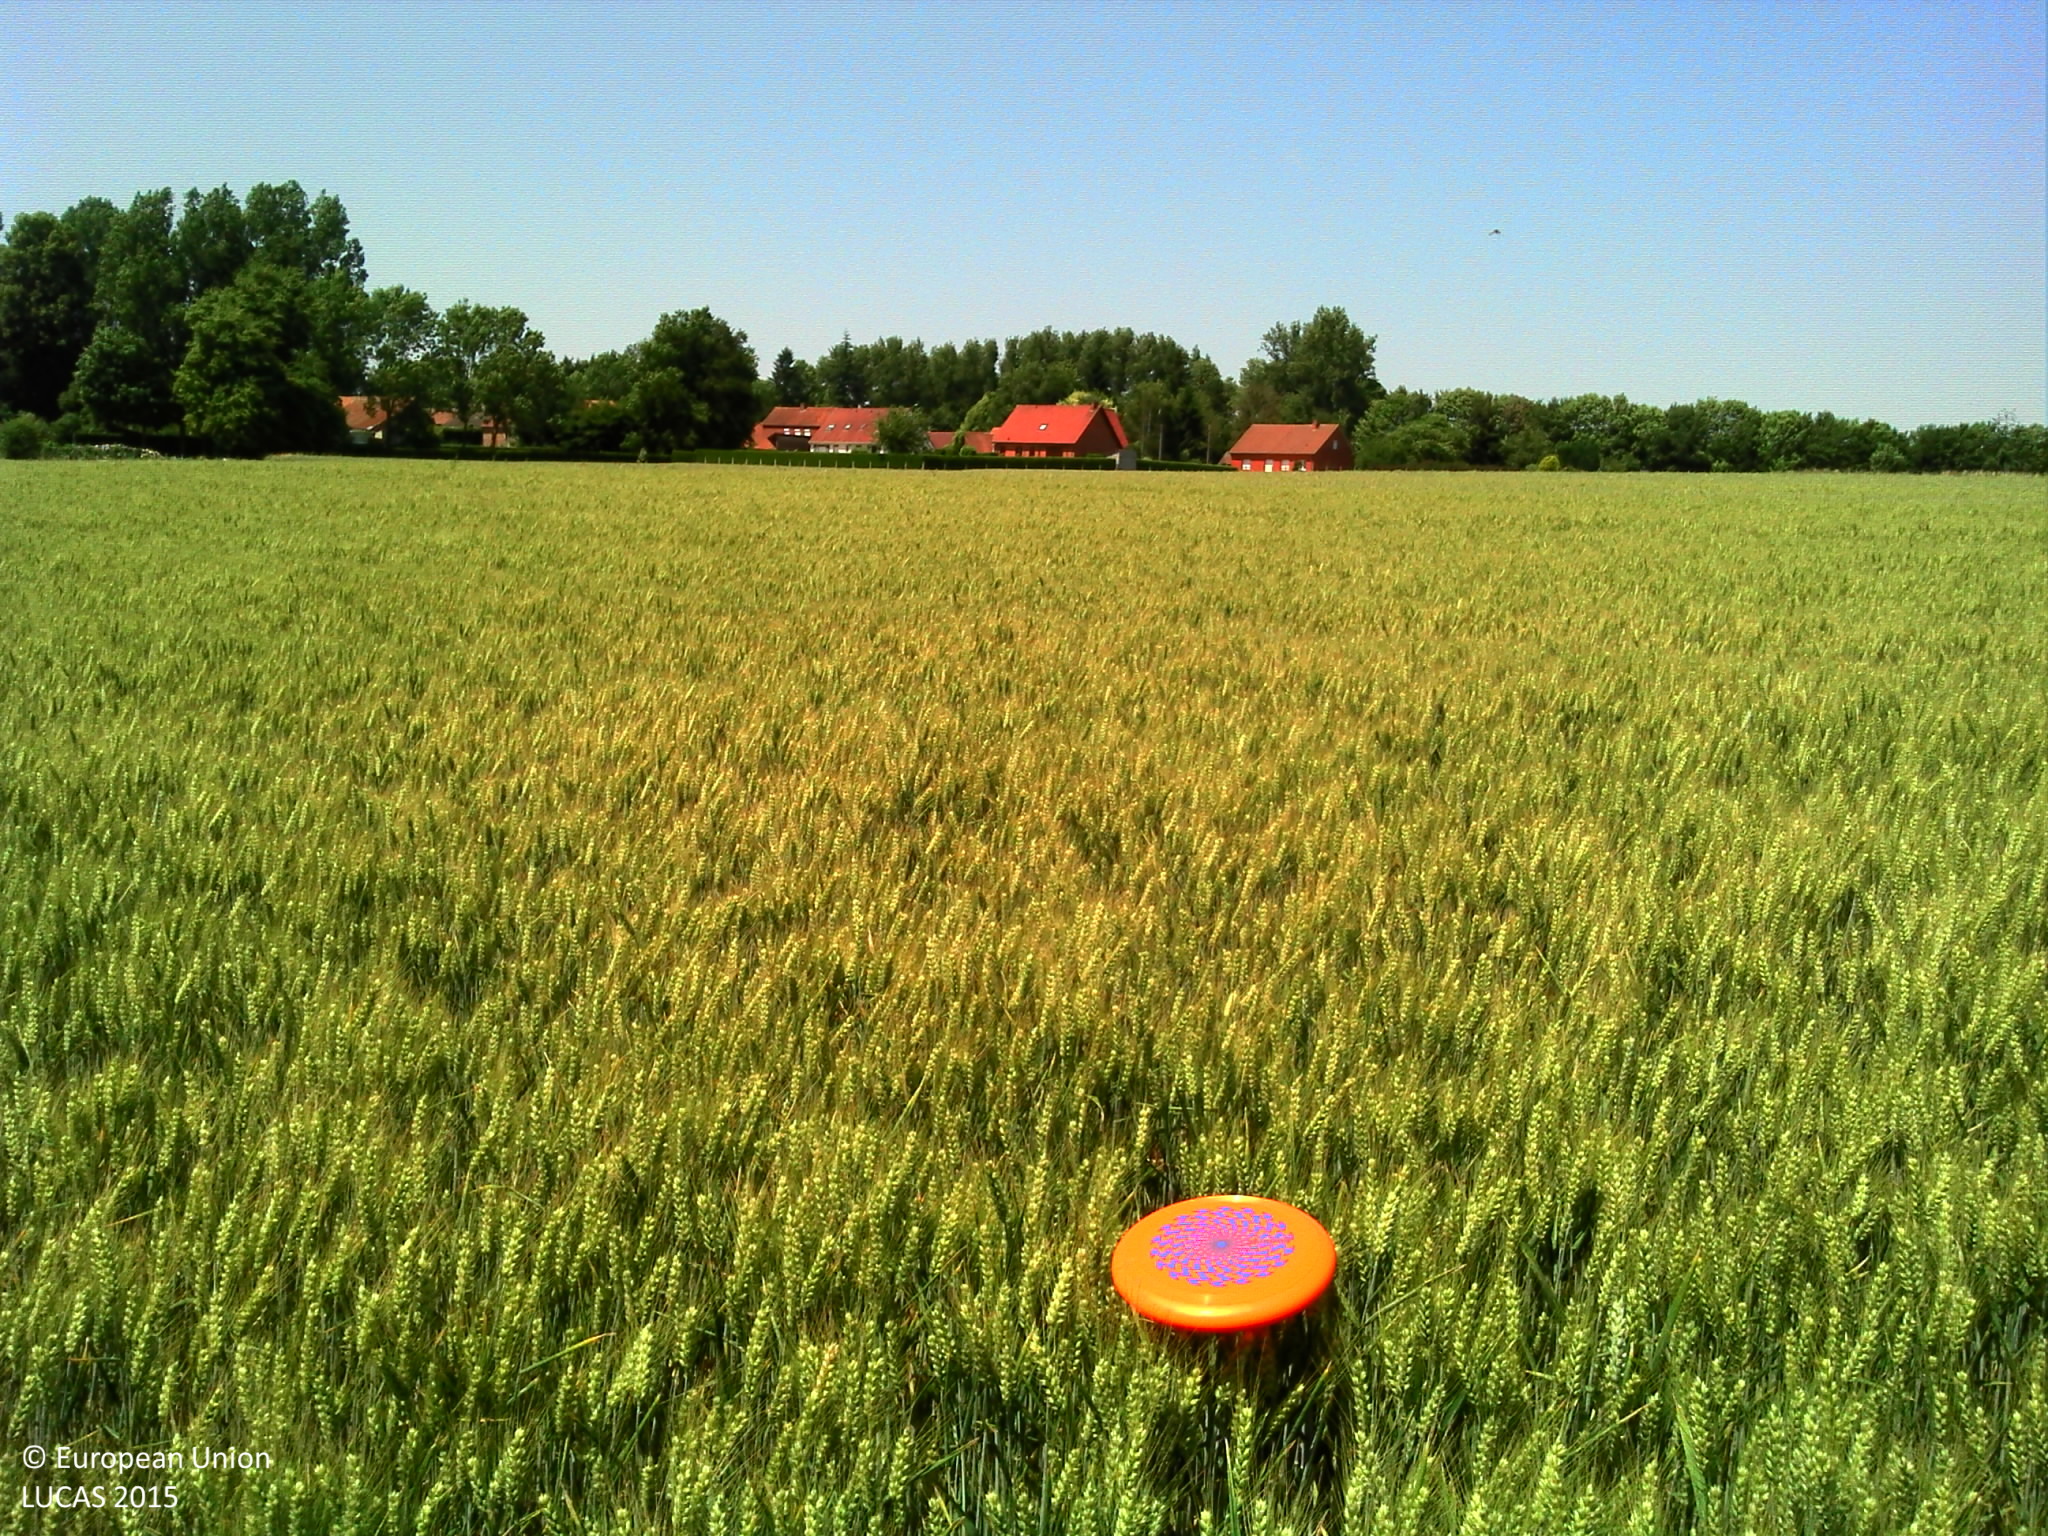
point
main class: Cropland
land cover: Common wheat
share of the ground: > 75 %
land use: Agriculture (excluding fallow land and kitchen gardens)
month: July
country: FR
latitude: 50.2807
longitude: 2.5078
